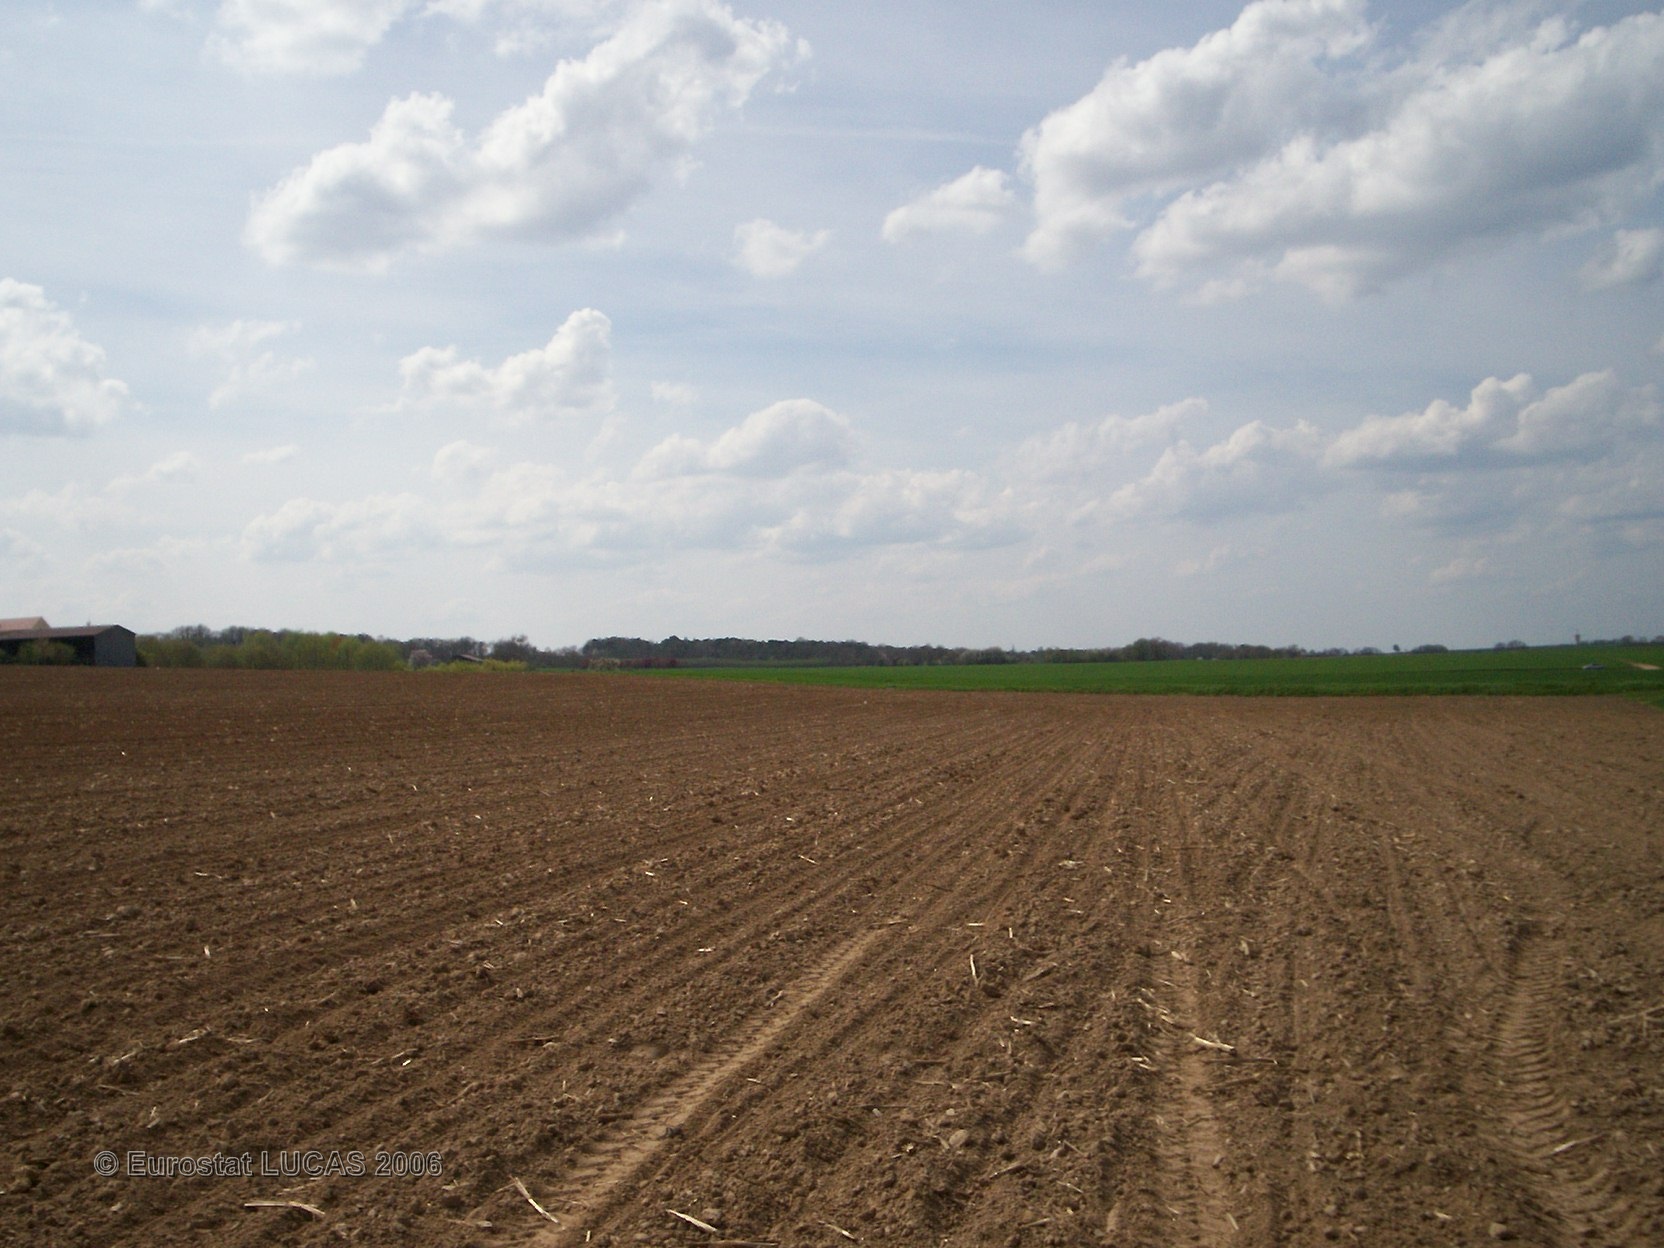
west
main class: Cropland
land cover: Sugar beet
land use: Agriculture (excluding fallow land and kitchen gardens)
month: April
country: FR
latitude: 48.3400
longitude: 2.9359
